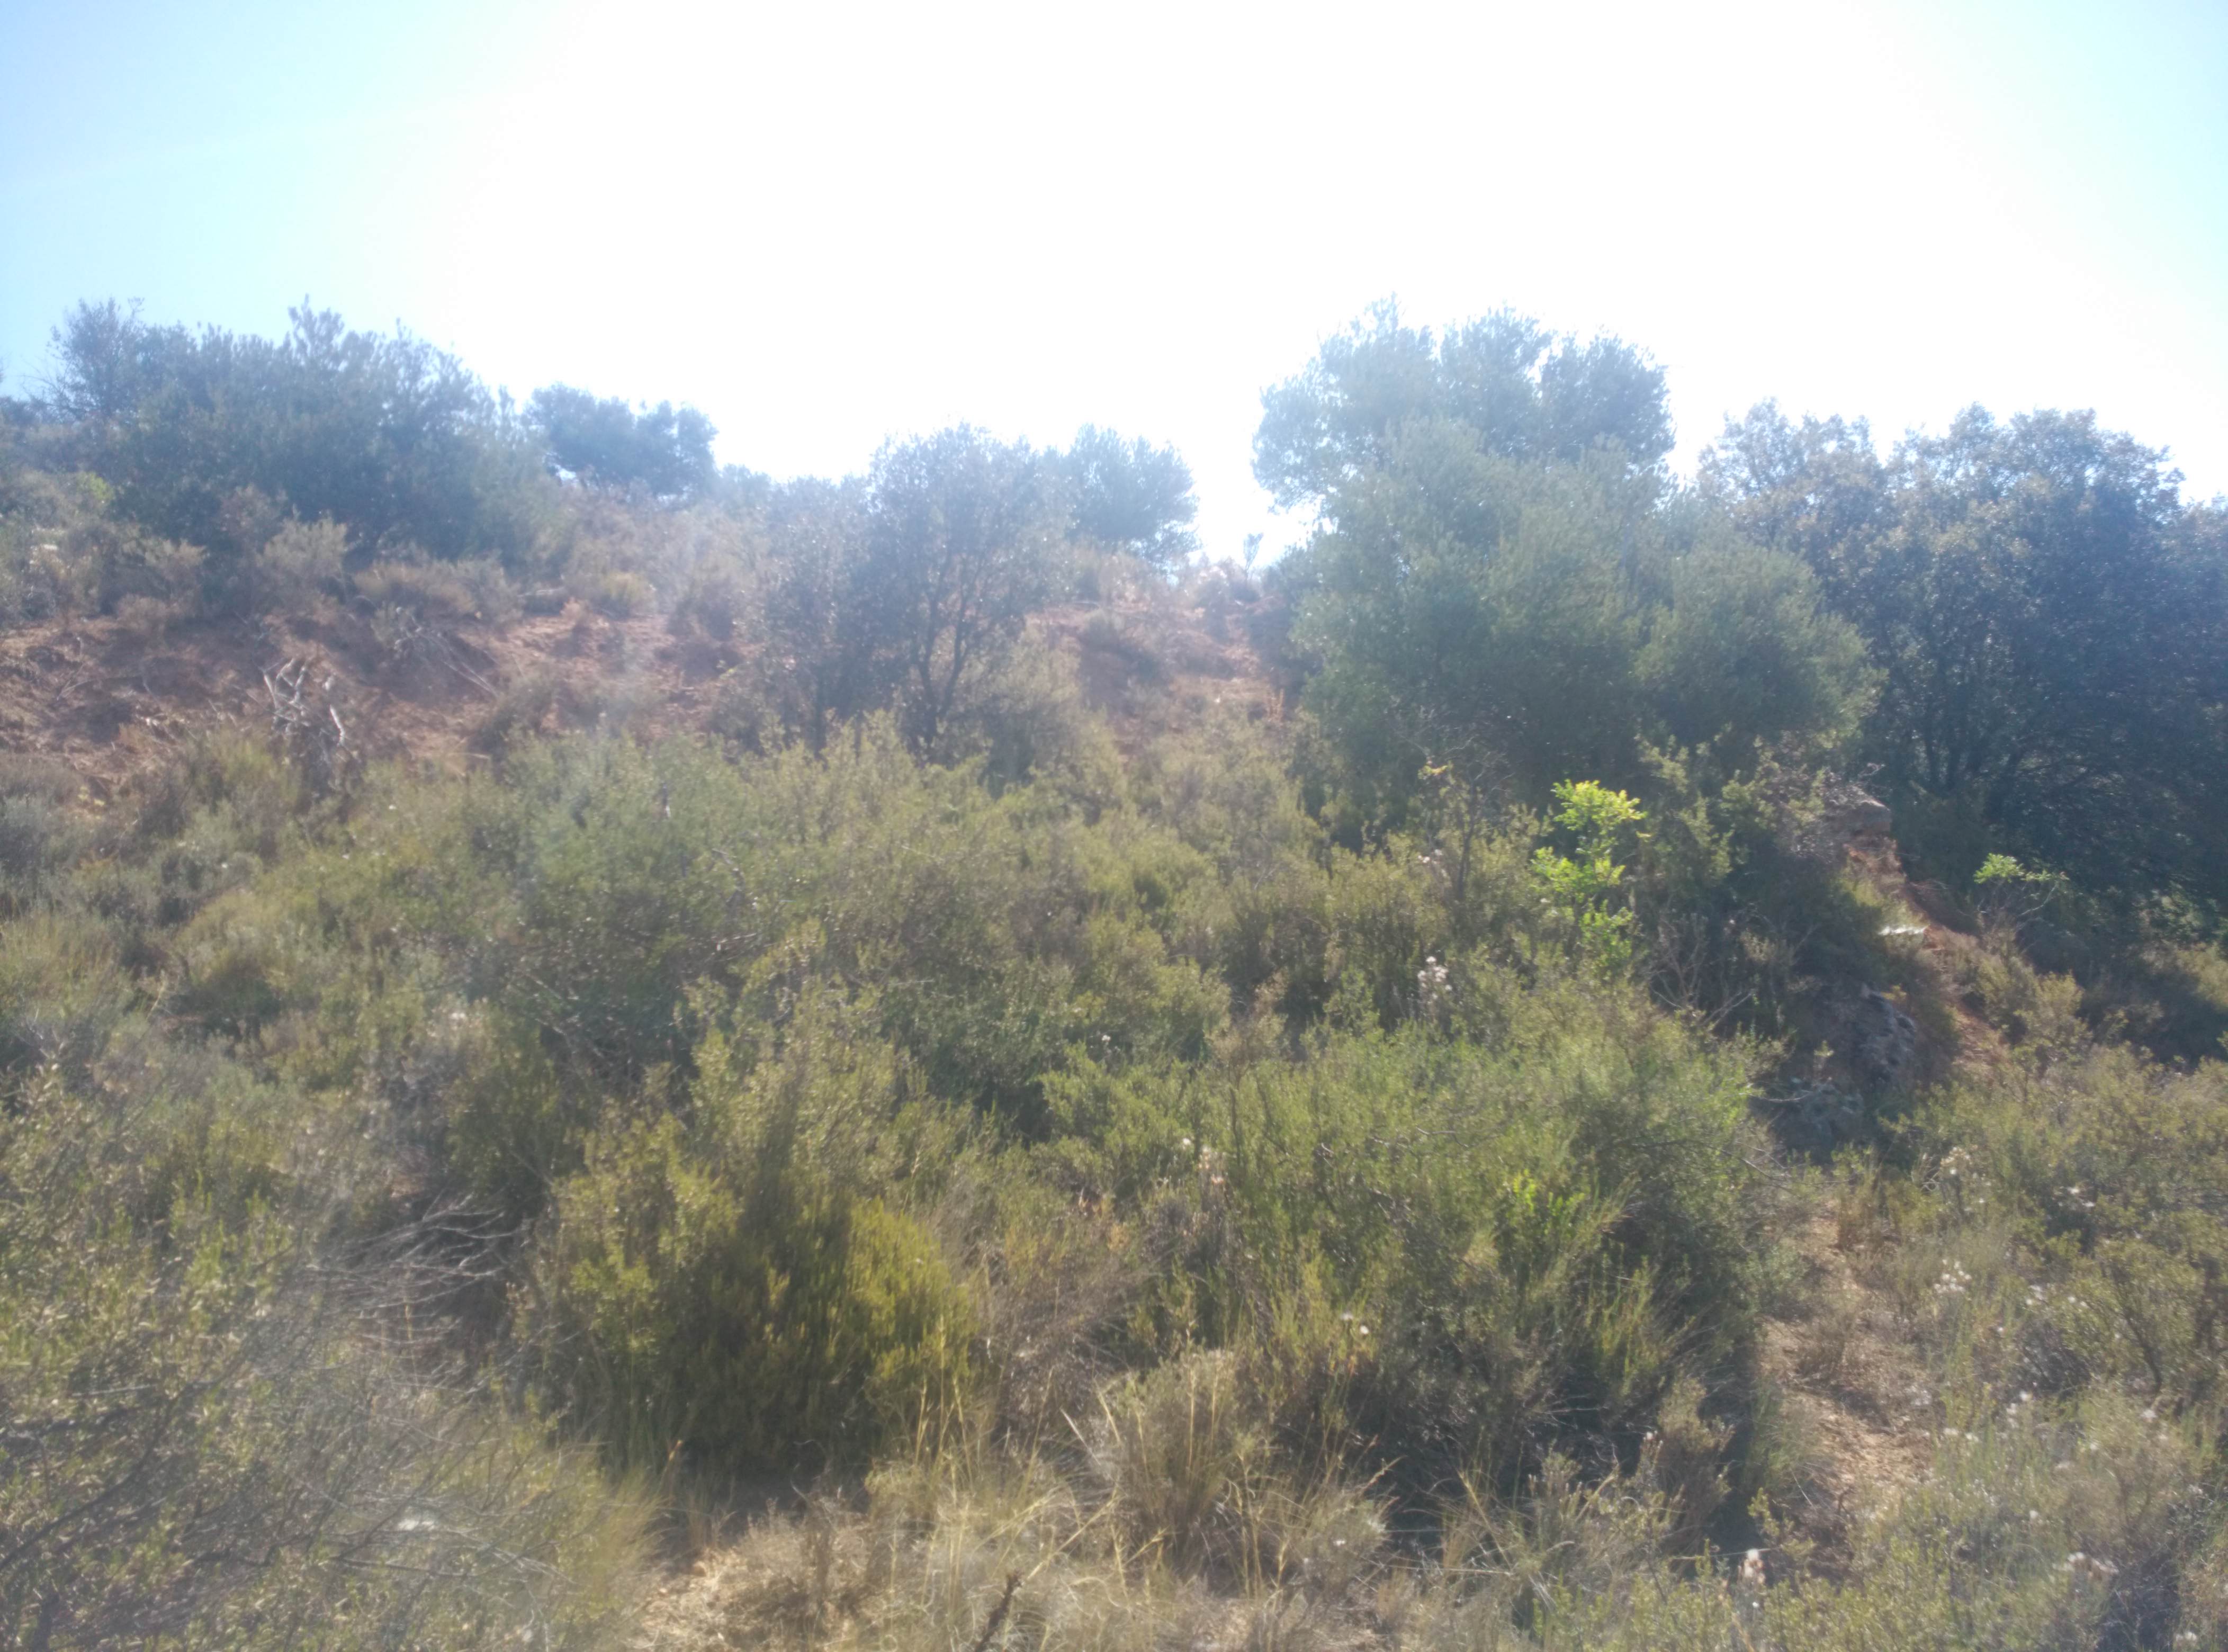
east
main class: Cropland
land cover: Olive groves
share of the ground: 10 - 25 %
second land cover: Shrubland without tree cover
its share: 50 - 75 %
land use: Agriculture (excluding fallow land and kitchen gardens)
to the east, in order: Olive groves; Shrubland without tree cover; Shrubland with sparse tree cover
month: July
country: ES
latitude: 40.7378
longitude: -2.8316
